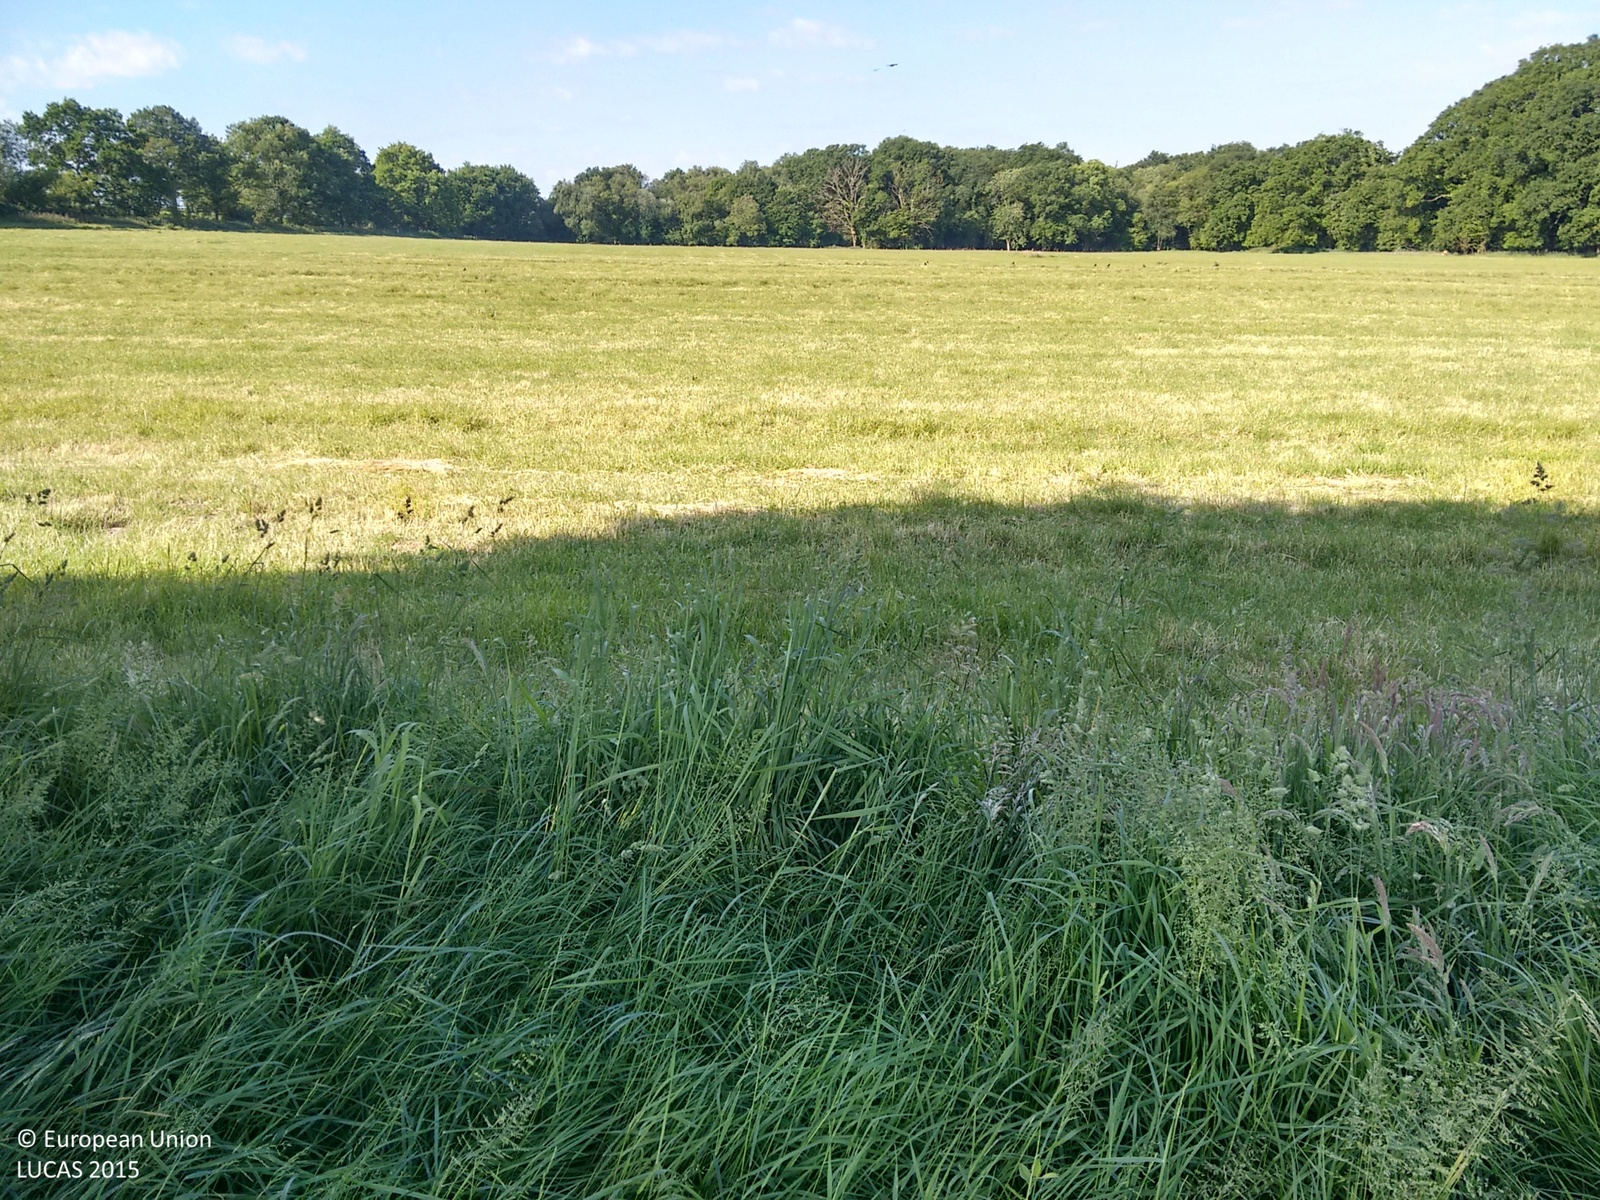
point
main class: Grassland
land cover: Grassland without tree/shrub cover
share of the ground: > 75 %
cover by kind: herbaceous plants 100 %
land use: Agriculture (excluding fallow land and kitchen gardens)
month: June
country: GB
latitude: 50.9875
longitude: -1.4326
